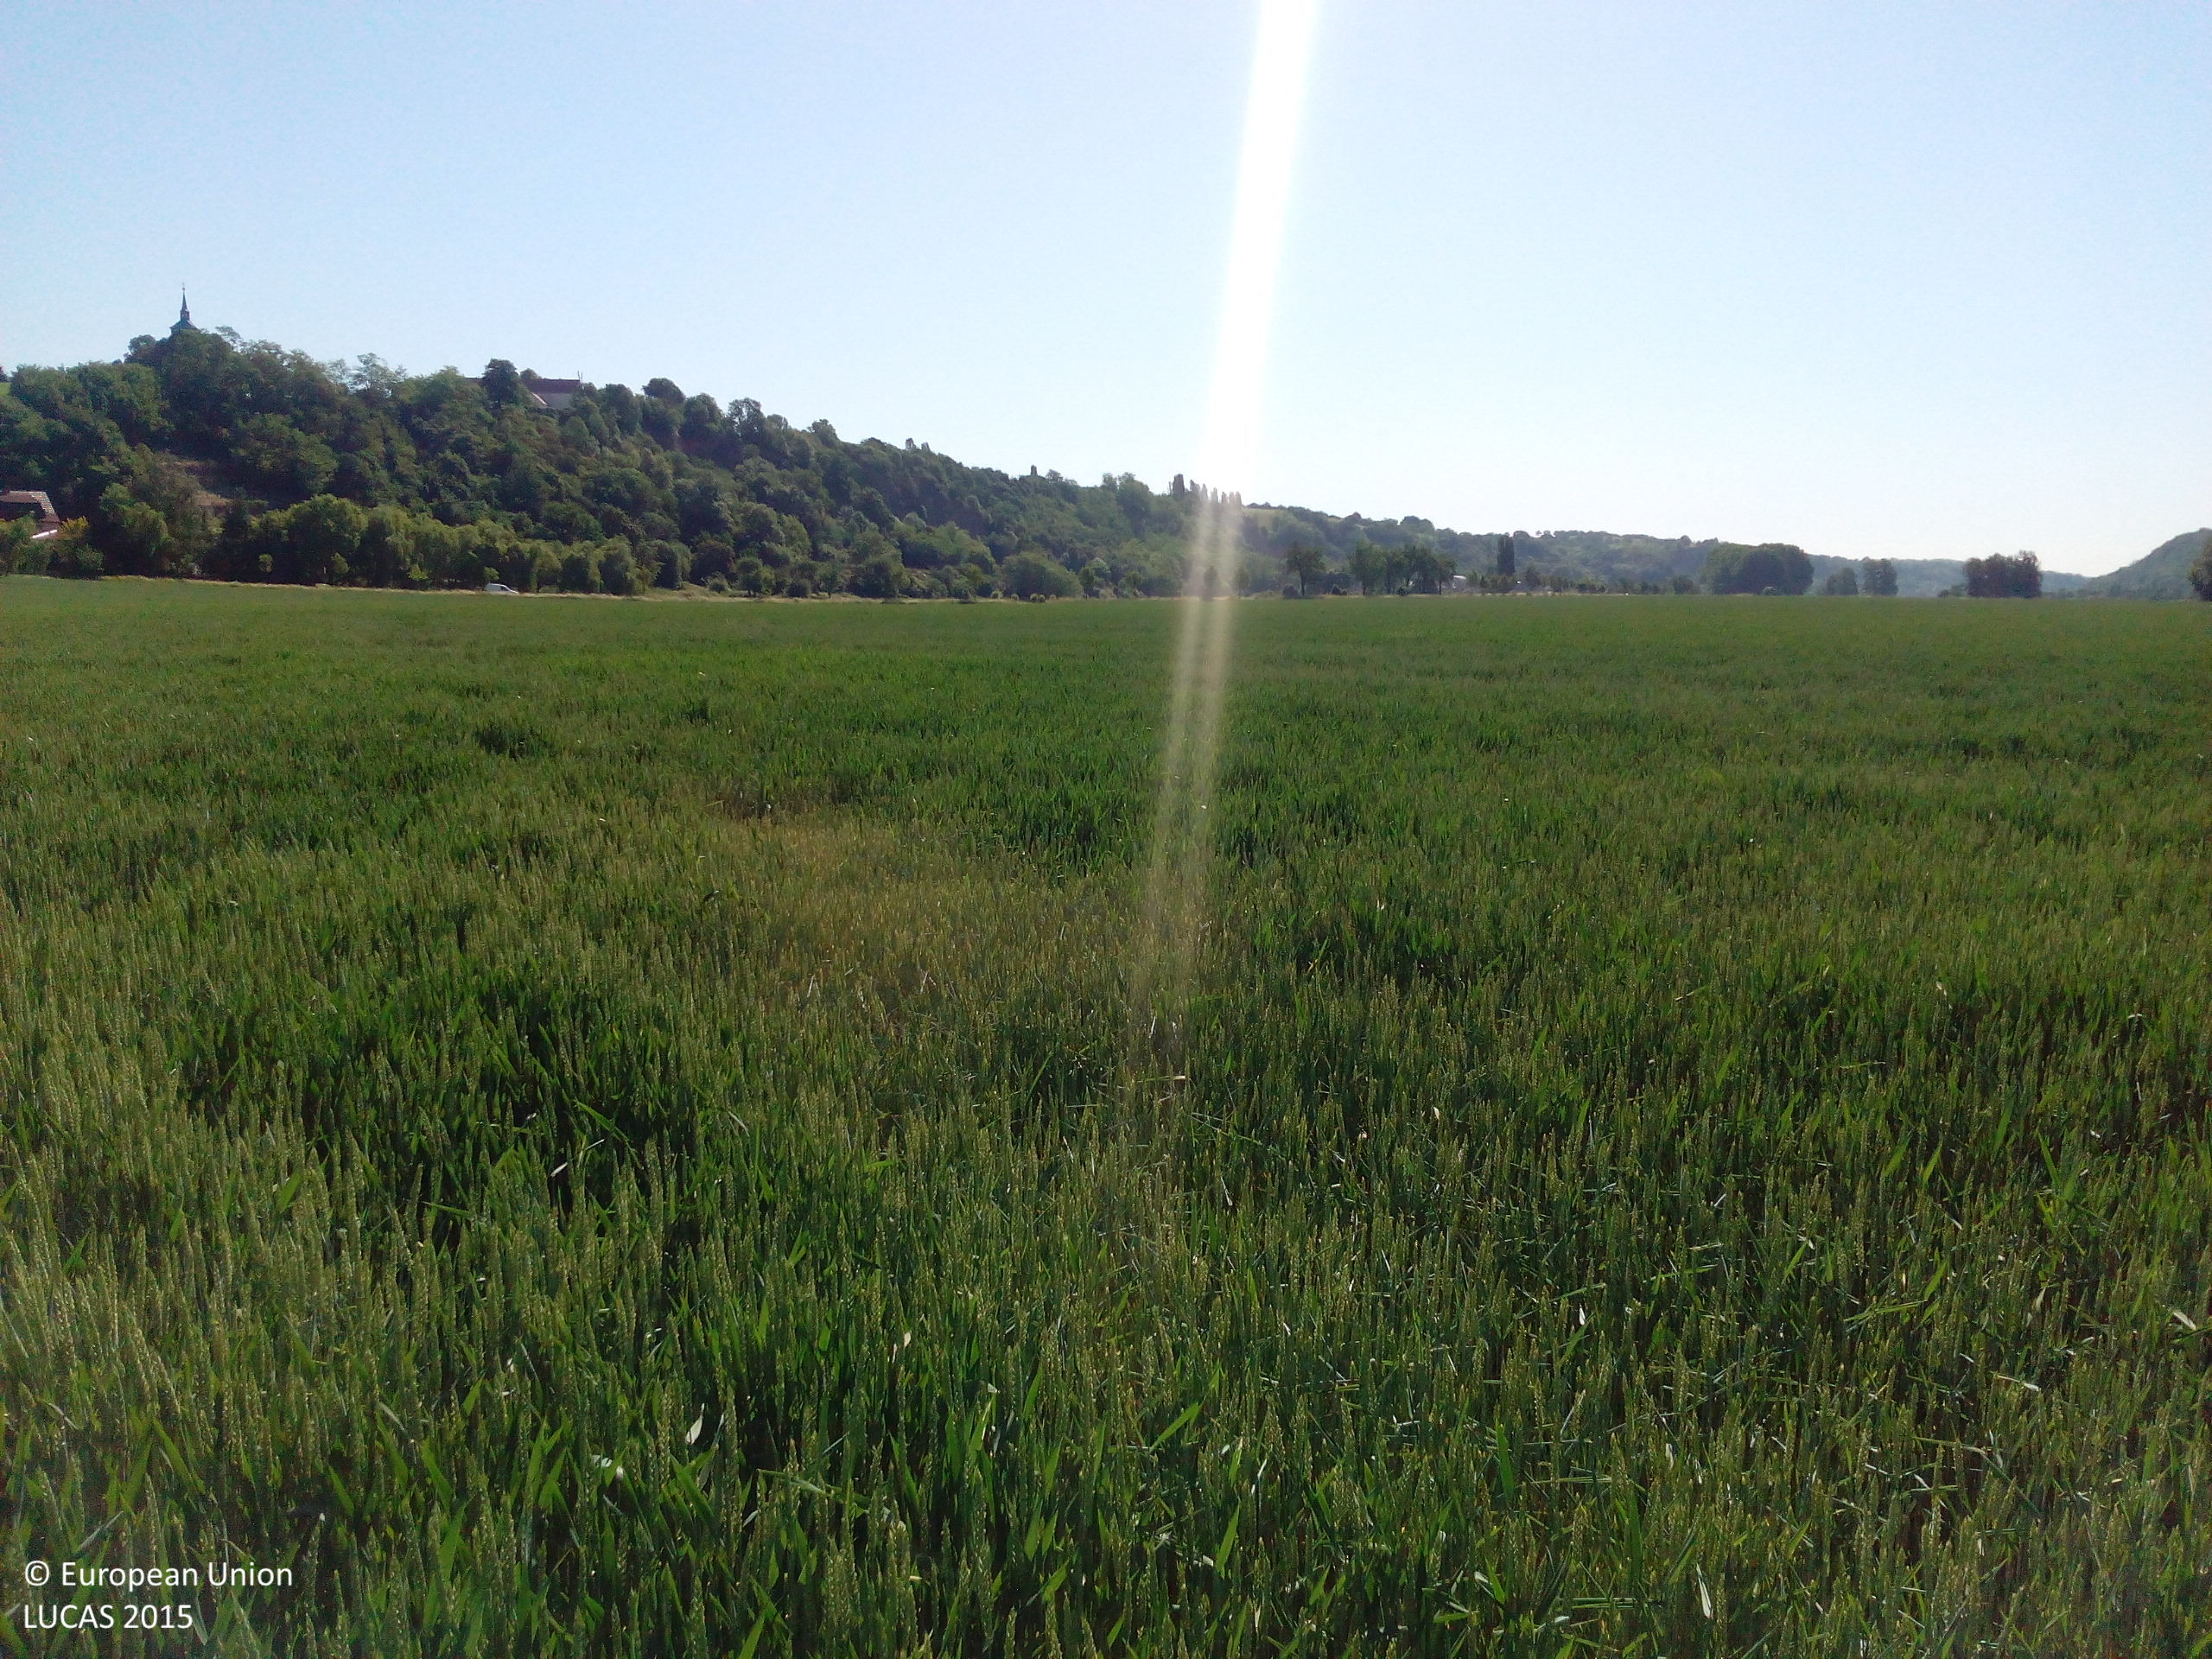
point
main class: Cropland
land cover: Common wheat
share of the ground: > 75 %
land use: Agriculture (excluding fallow land and kitchen gardens)
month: June
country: DE
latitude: 51.1947
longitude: 13.4204
